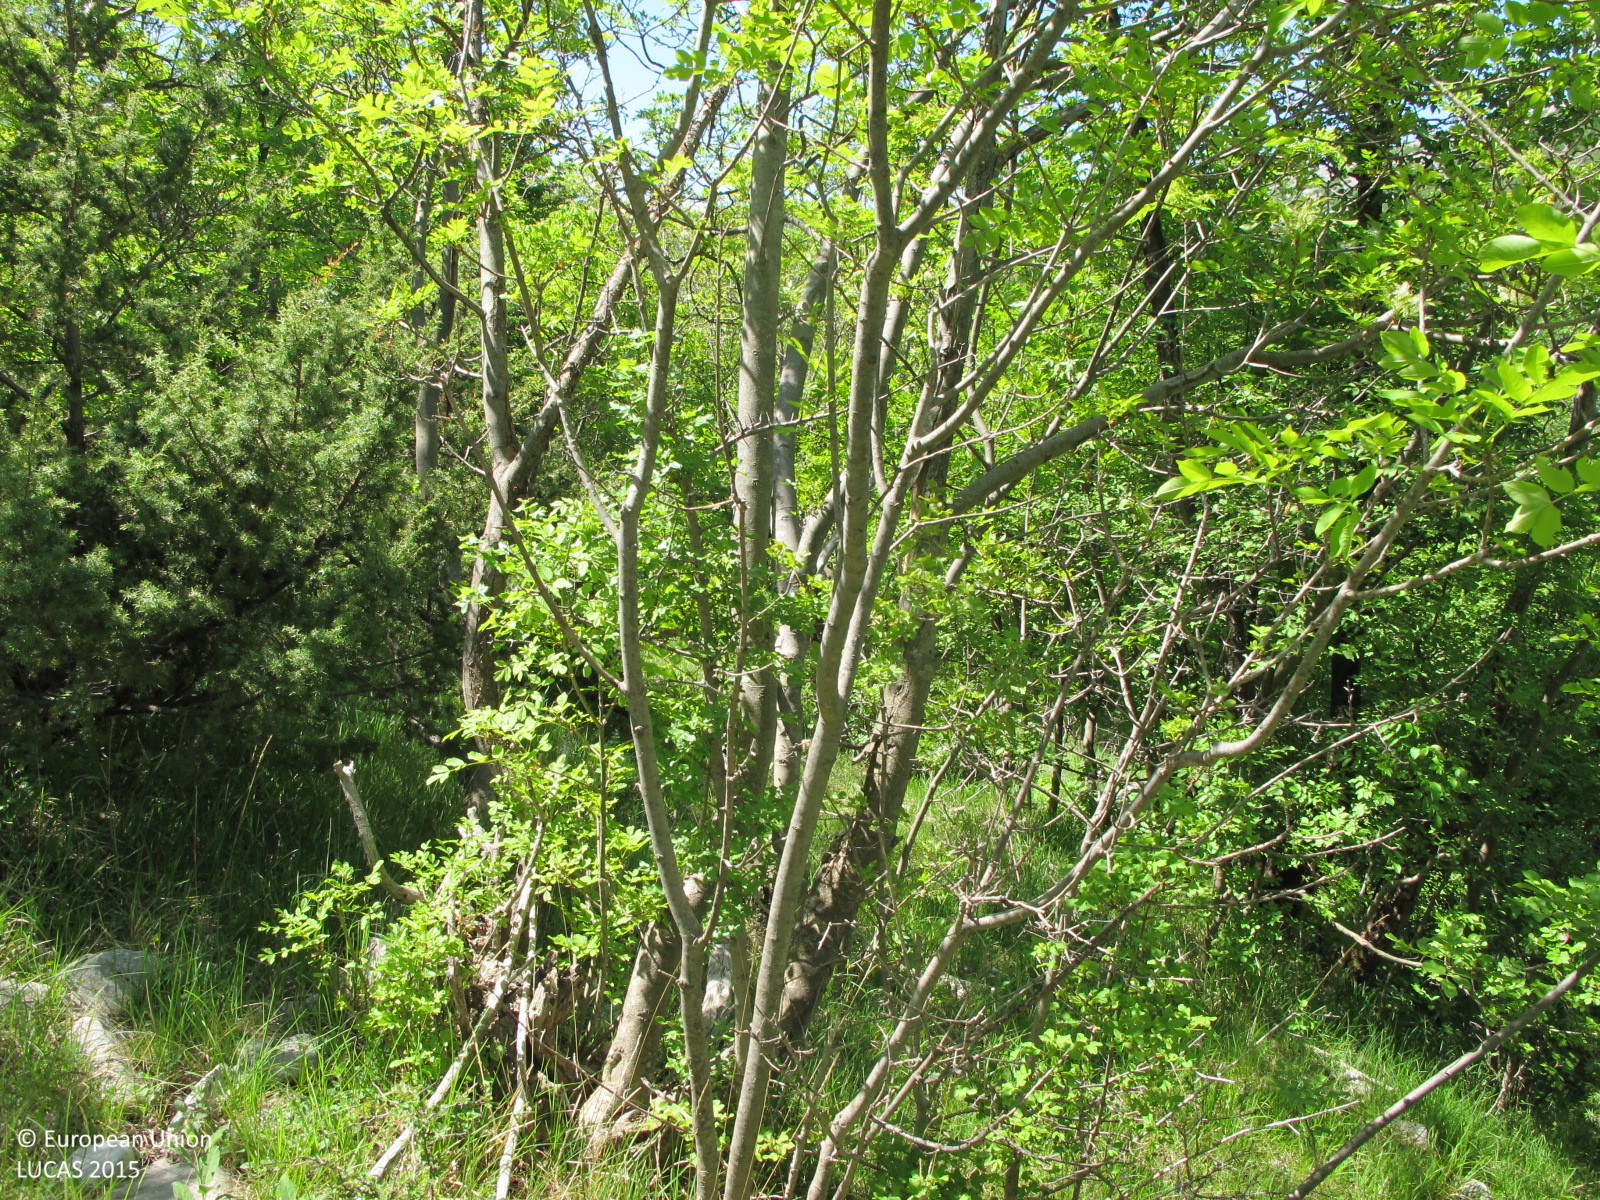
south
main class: Woodland
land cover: Broadleaved woodland
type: mesophytic deciduous forest
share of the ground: > 75 %
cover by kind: broadleaved forest trees 70 %, coniferous forest trees 10 %, shrubs 10 %, herbaceous plants 5 %, consolidated bare surface 5 %
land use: Forestry
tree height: < 5 m
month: May
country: HR
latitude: 45.1587
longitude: 14.8414
